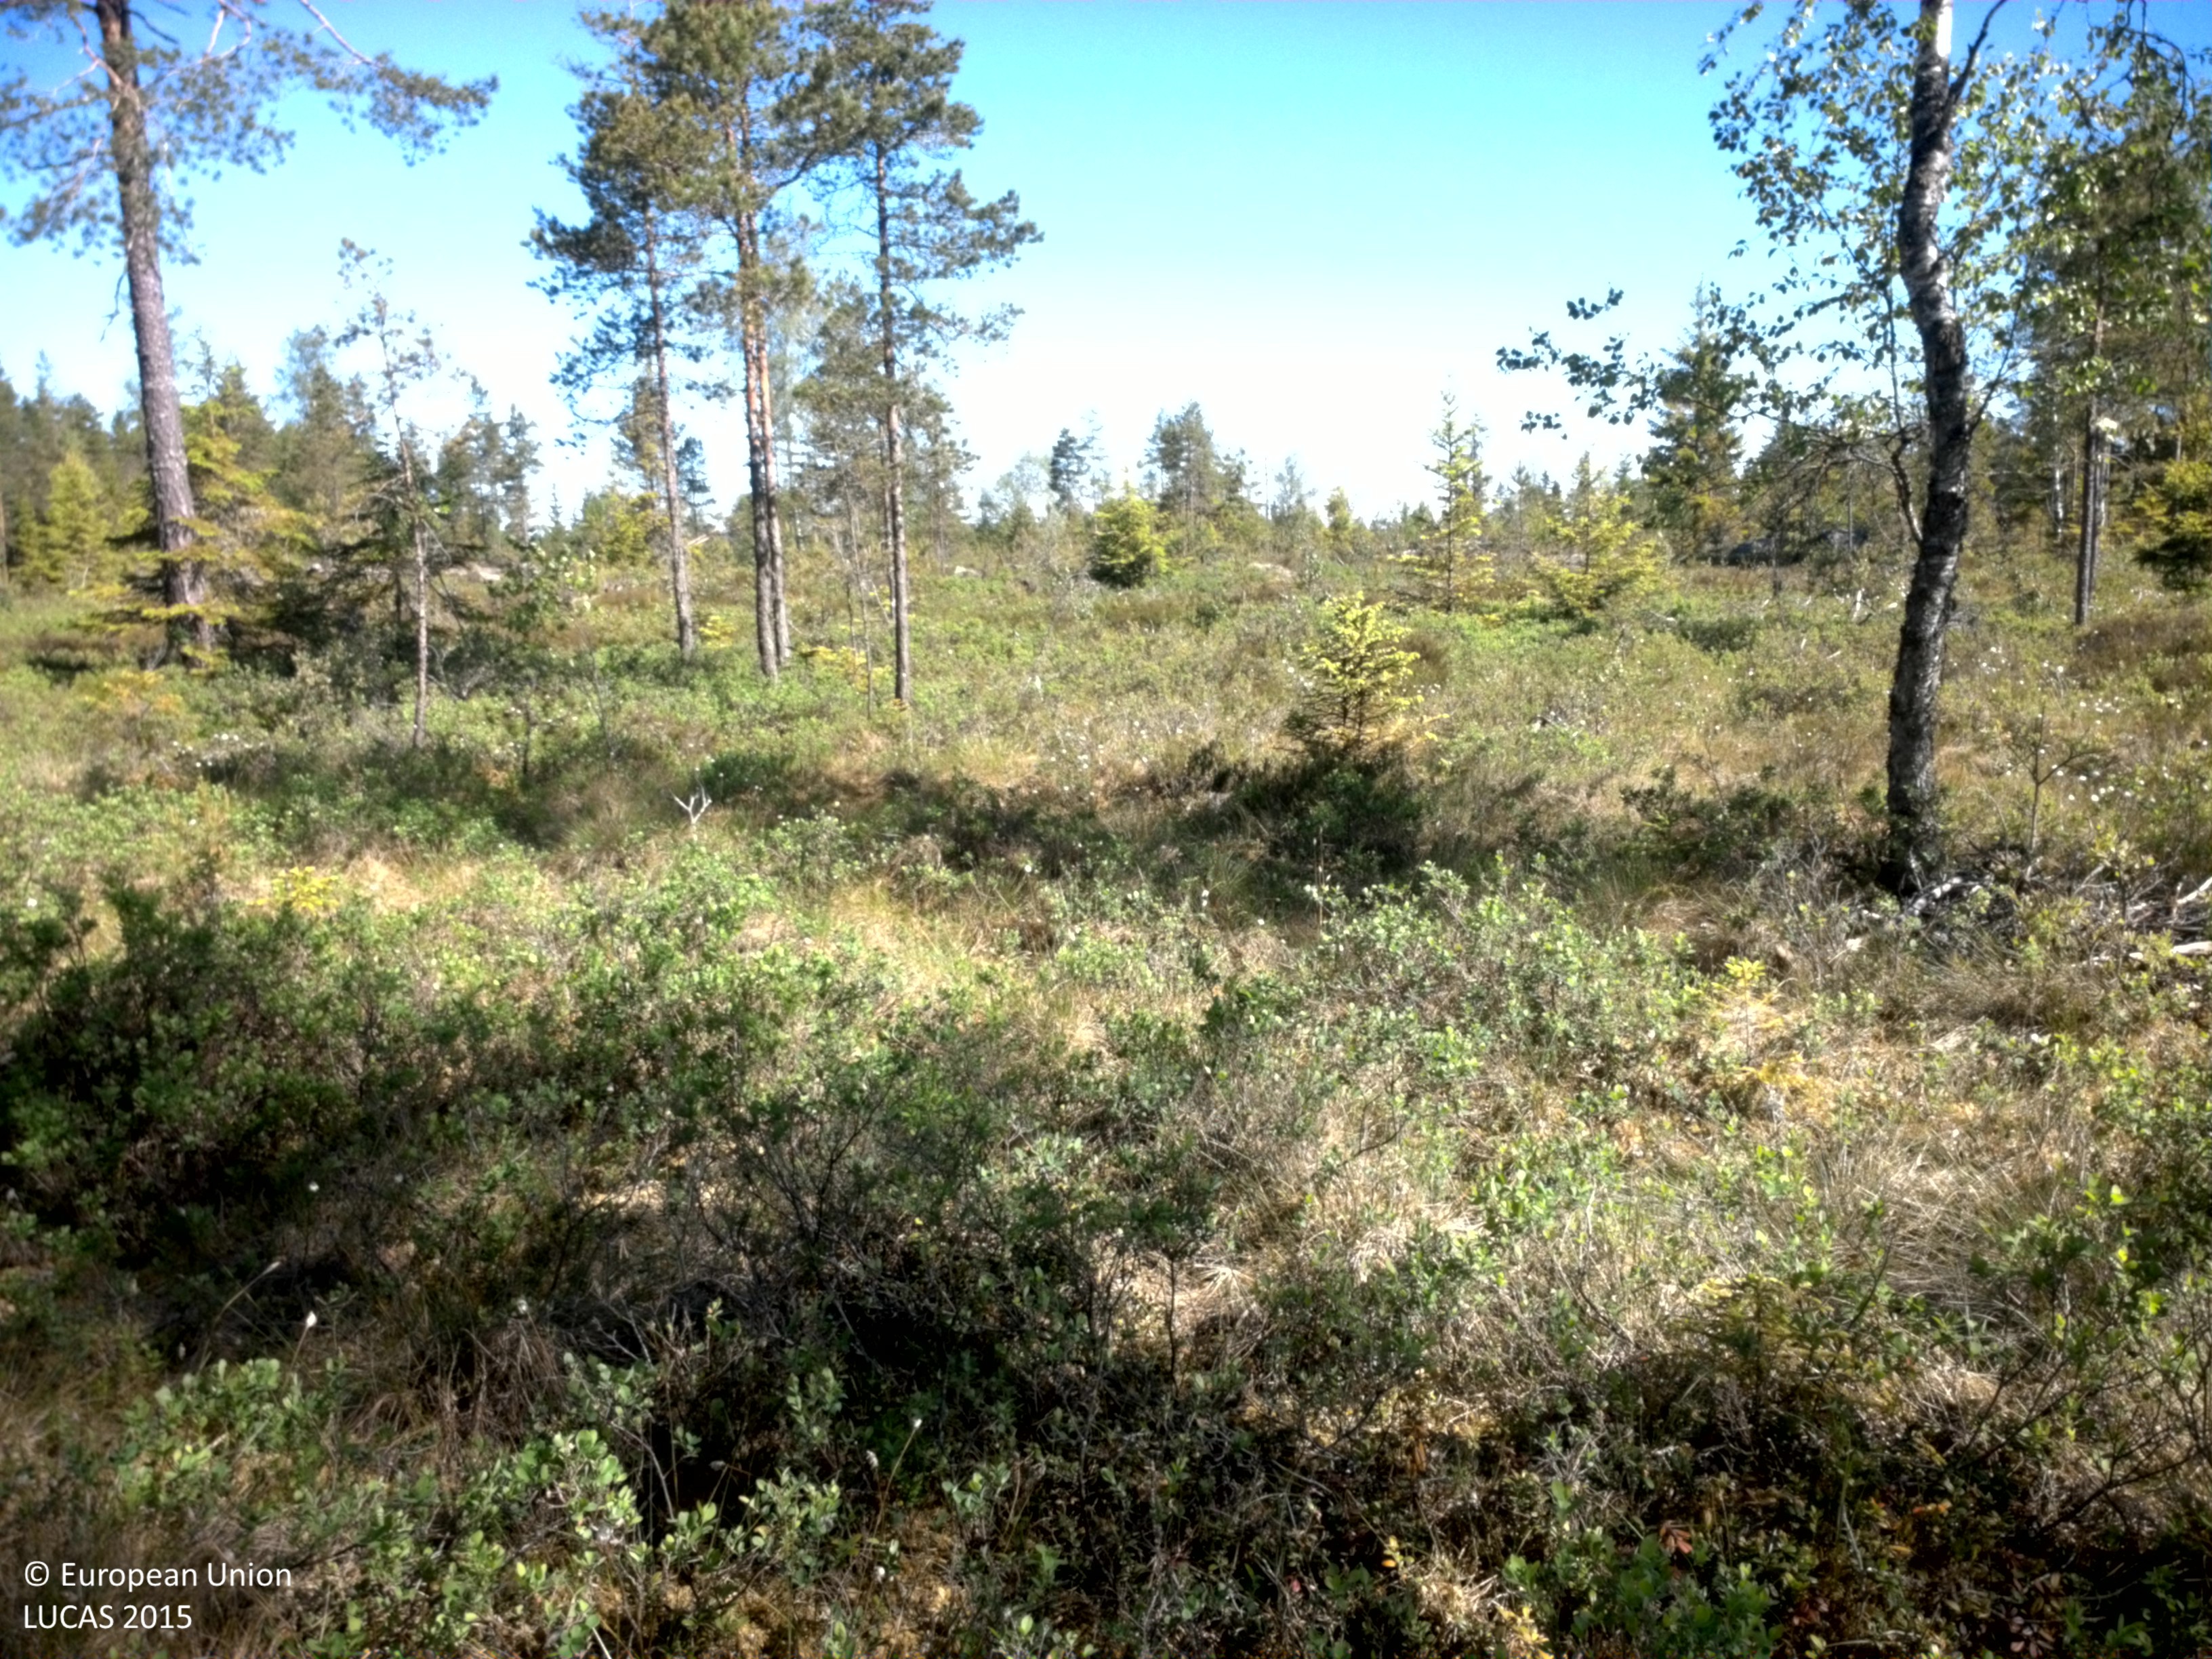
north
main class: Woodland
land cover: Pine dominated coniferous woodland
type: boreal forest
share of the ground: 50 - 75 %
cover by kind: coniferous forest trees 50 %, shrubs 25 %, herbaceous plants 10 %, lichens and mosses 10 %, broadleaved forest trees 5 %
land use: Forestry
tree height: > 5 m
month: June
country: SE
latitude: 59.4994
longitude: 12.0613
